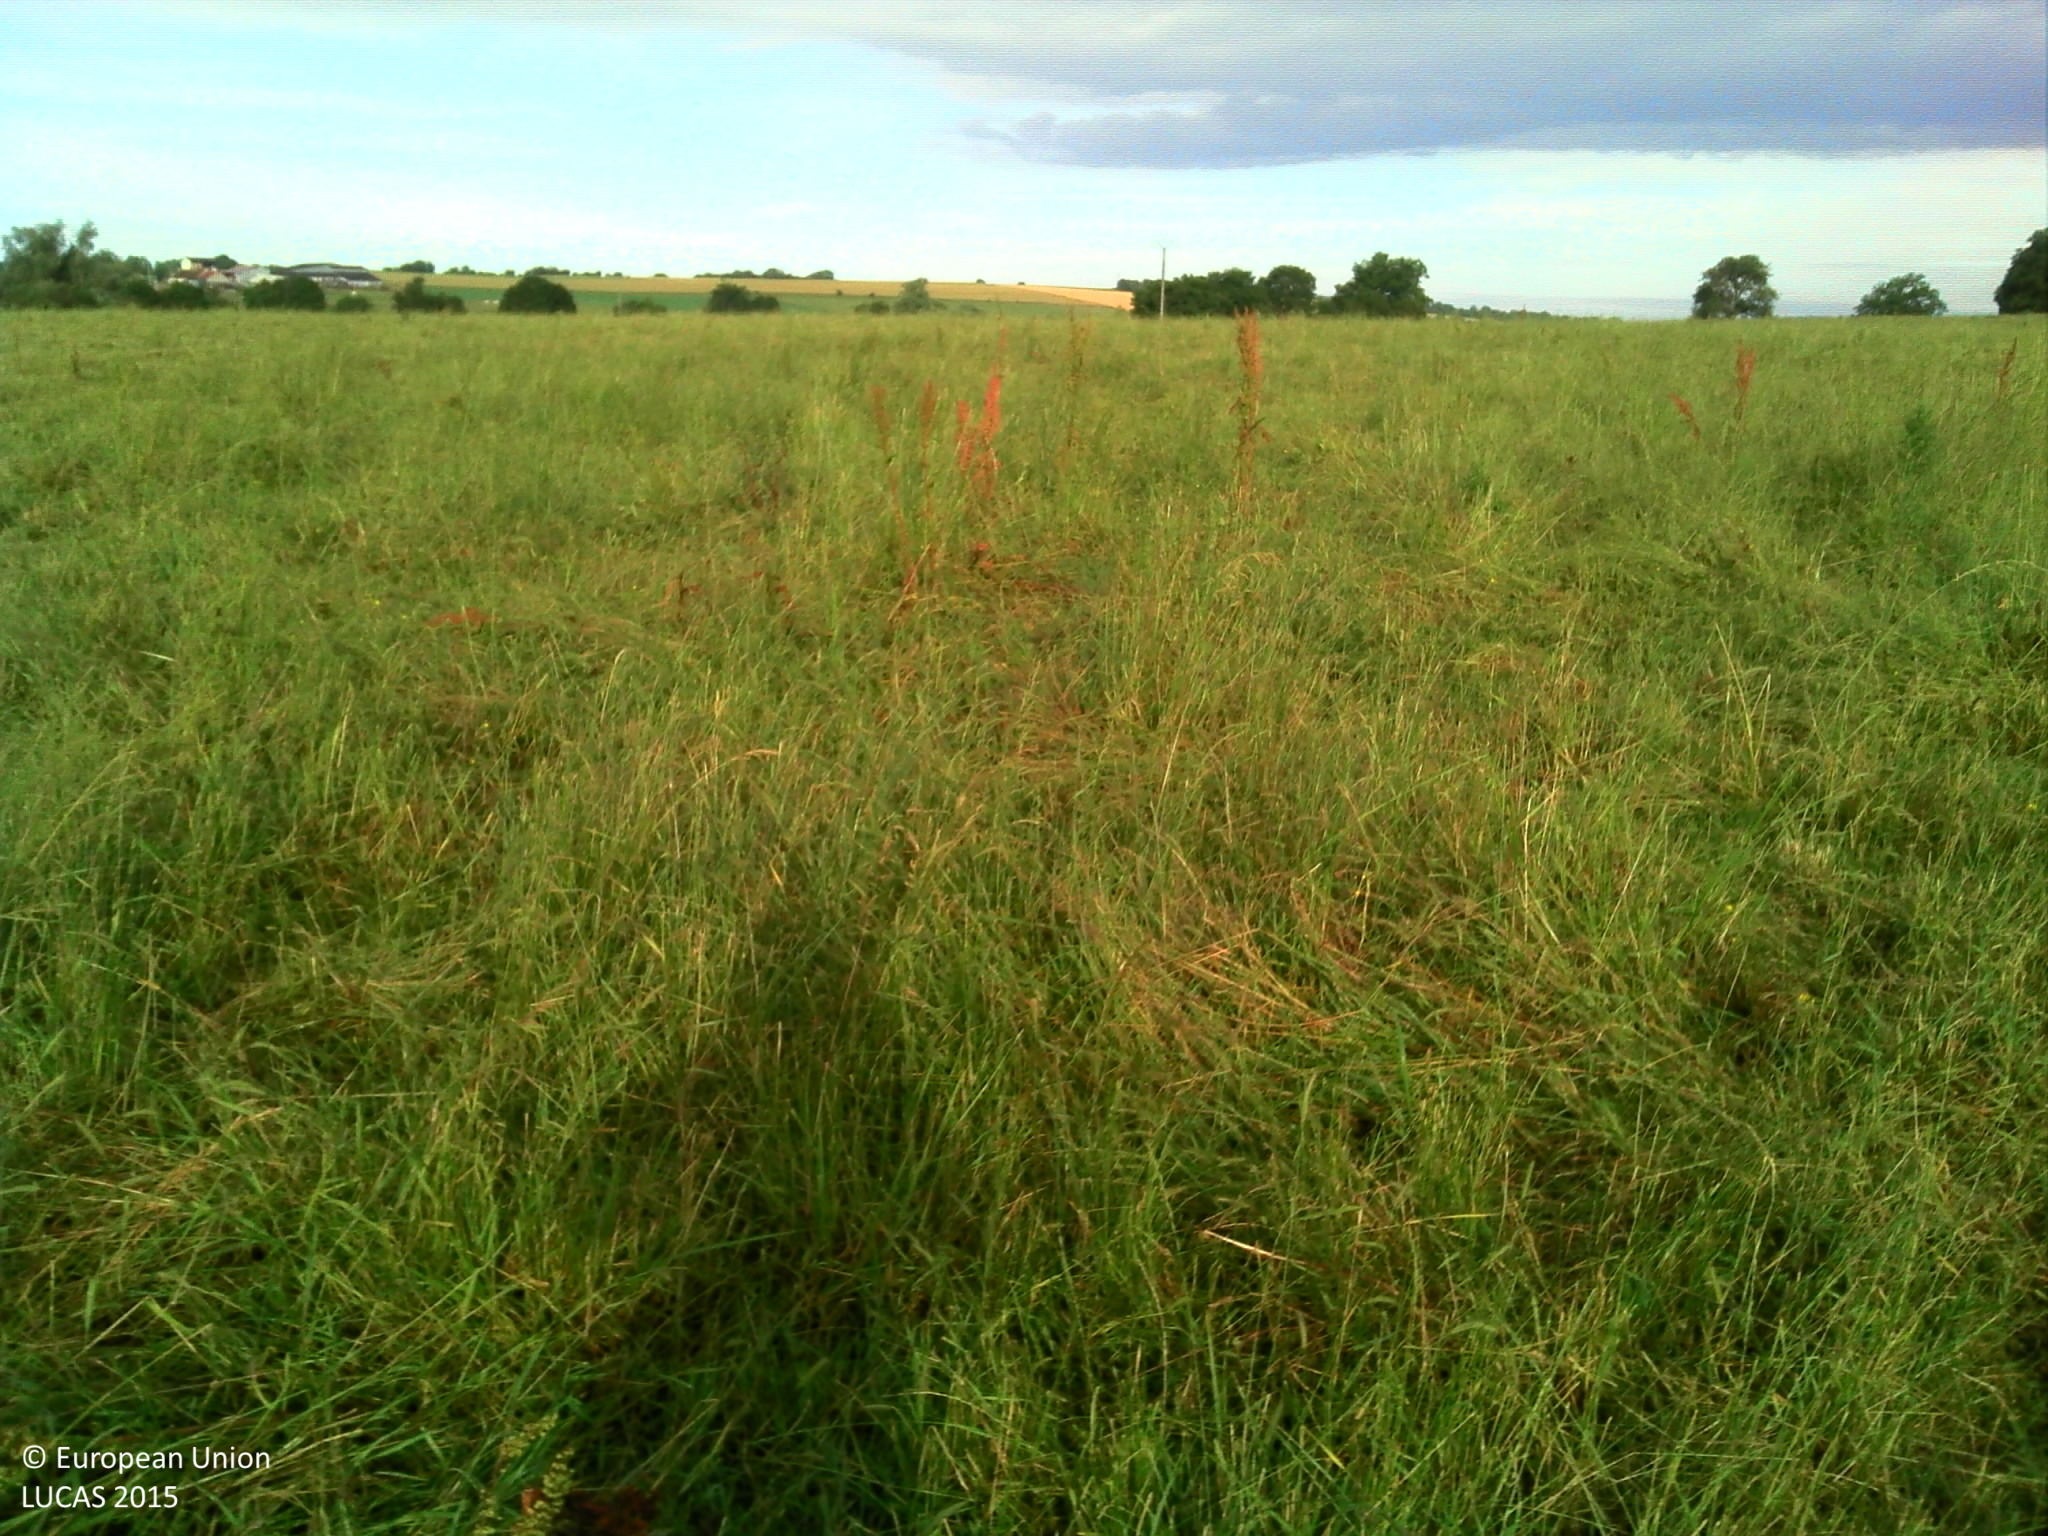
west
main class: Grassland
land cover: Grassland without tree/shrub cover
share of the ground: > 75 %
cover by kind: herbaceous plants 100 %
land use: Agriculture (excluding fallow land and kitchen gardens)
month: June
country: FR
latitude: 46.7151
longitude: 2.6824
